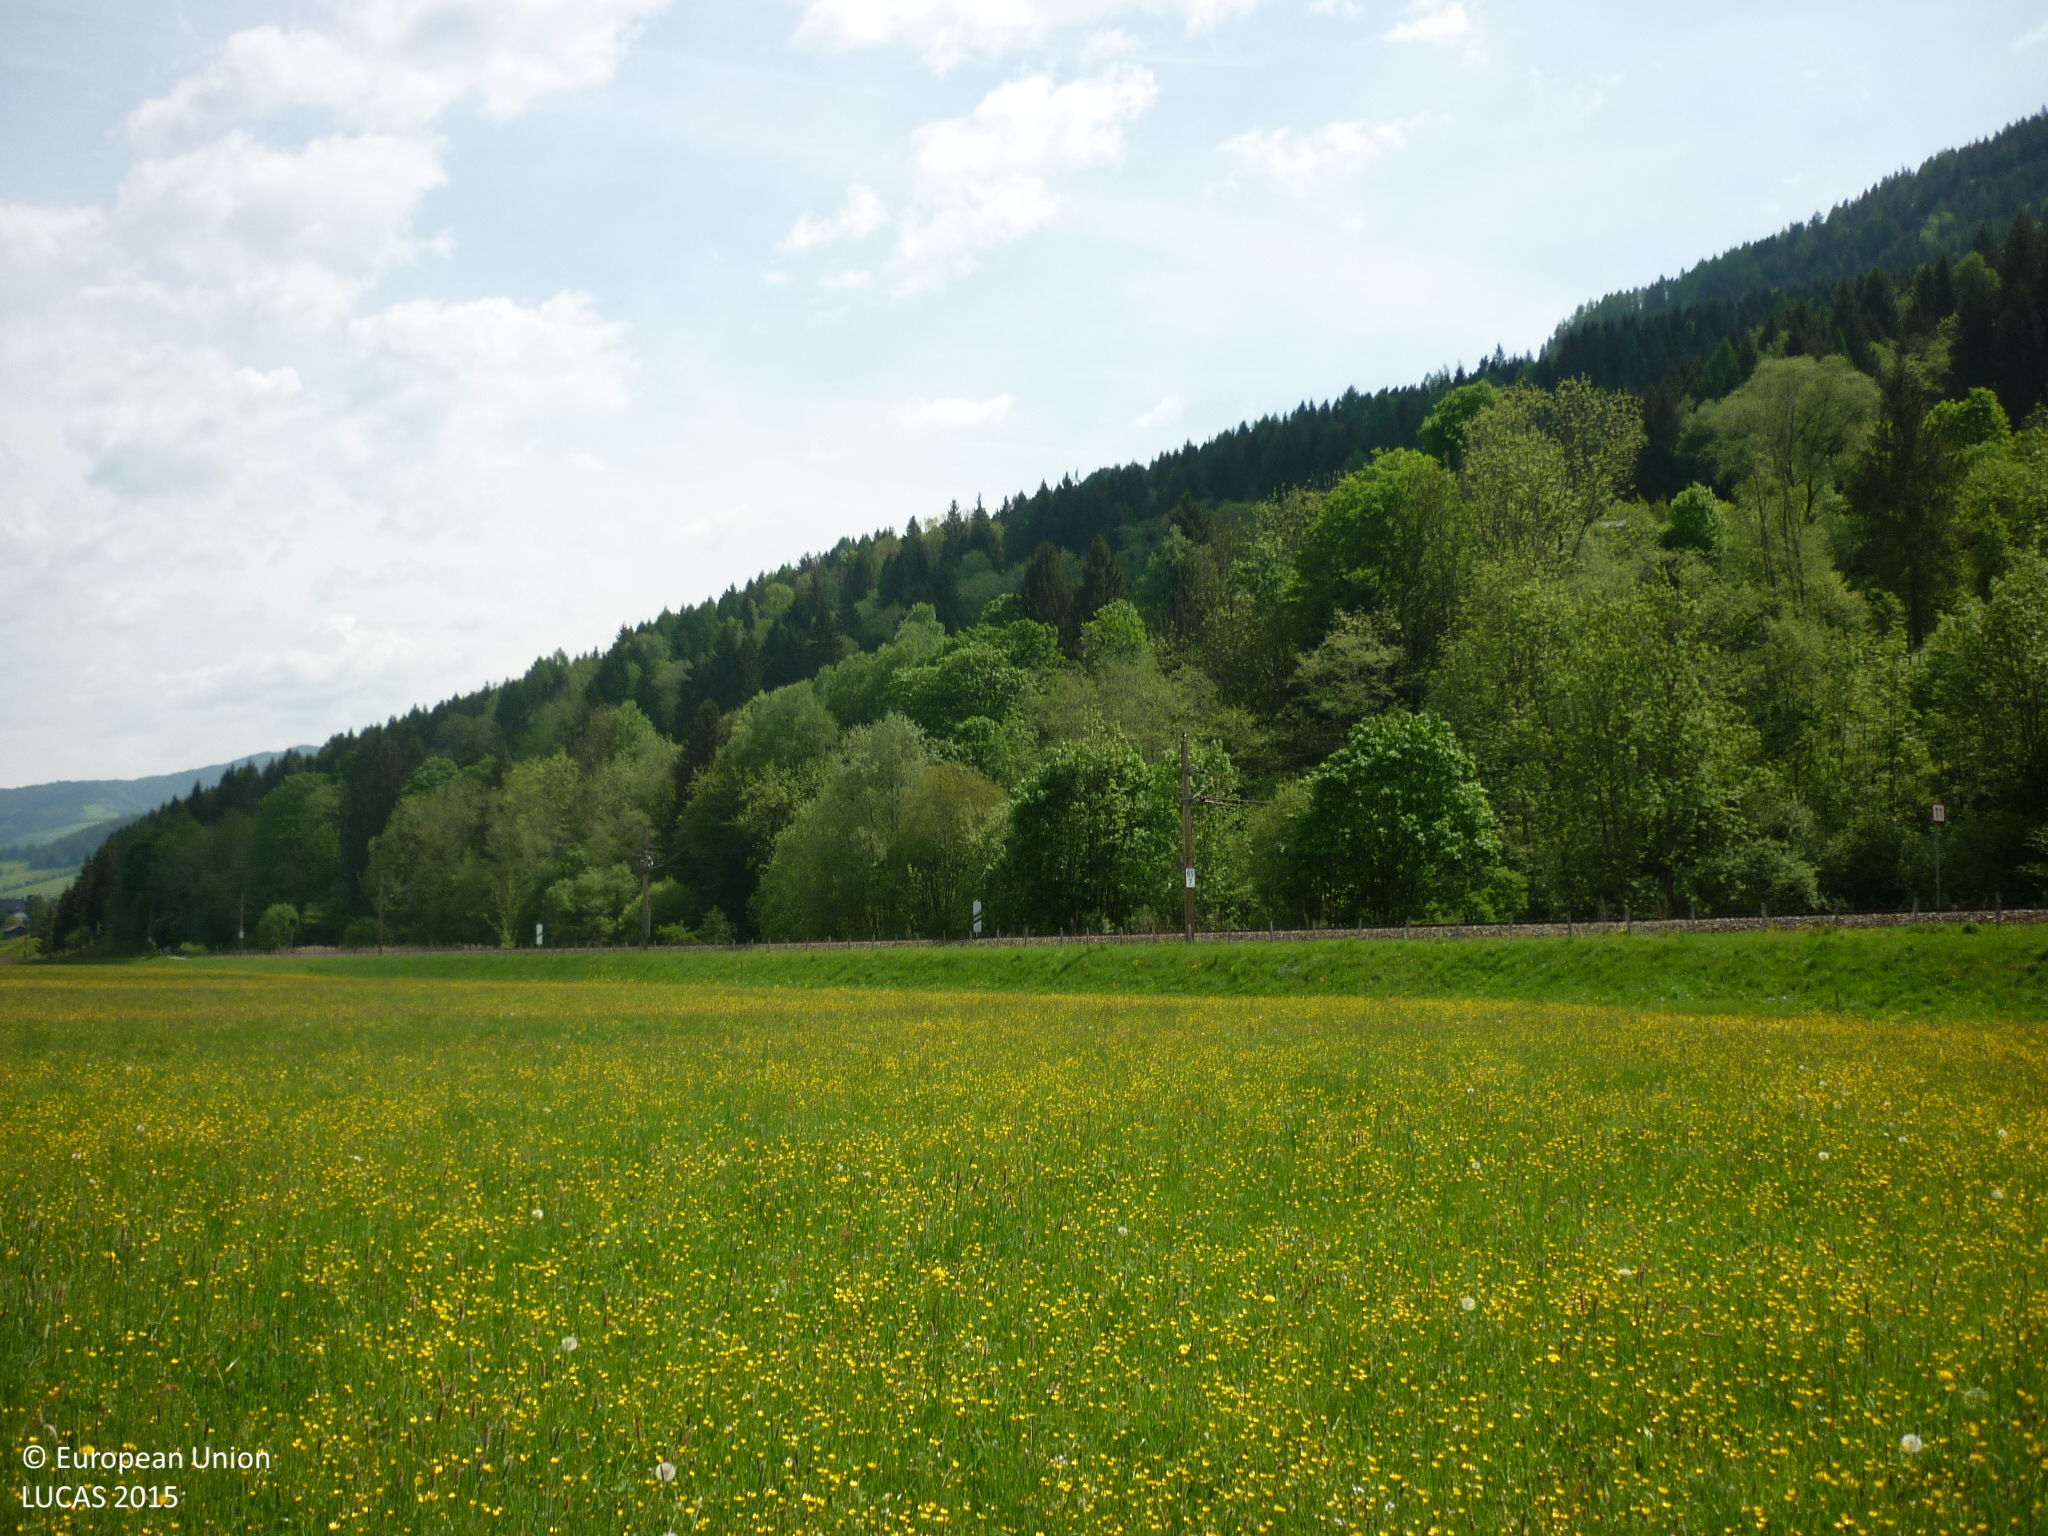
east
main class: Grassland
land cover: Grassland without tree/shrub cover
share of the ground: > 75 %
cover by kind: herbaceous plants 100 %
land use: Agriculture (excluding fallow land and kitchen gardens)
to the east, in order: Grassland without tree/shrub cover; Tracks; Grass margins; Fences; Grass margins; Electric lines; Railways; Grass margins; Broadleaved woodland; Grassland with sparse tree/shrub cover
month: May
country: AT
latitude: 47.4496
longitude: 13.9641
